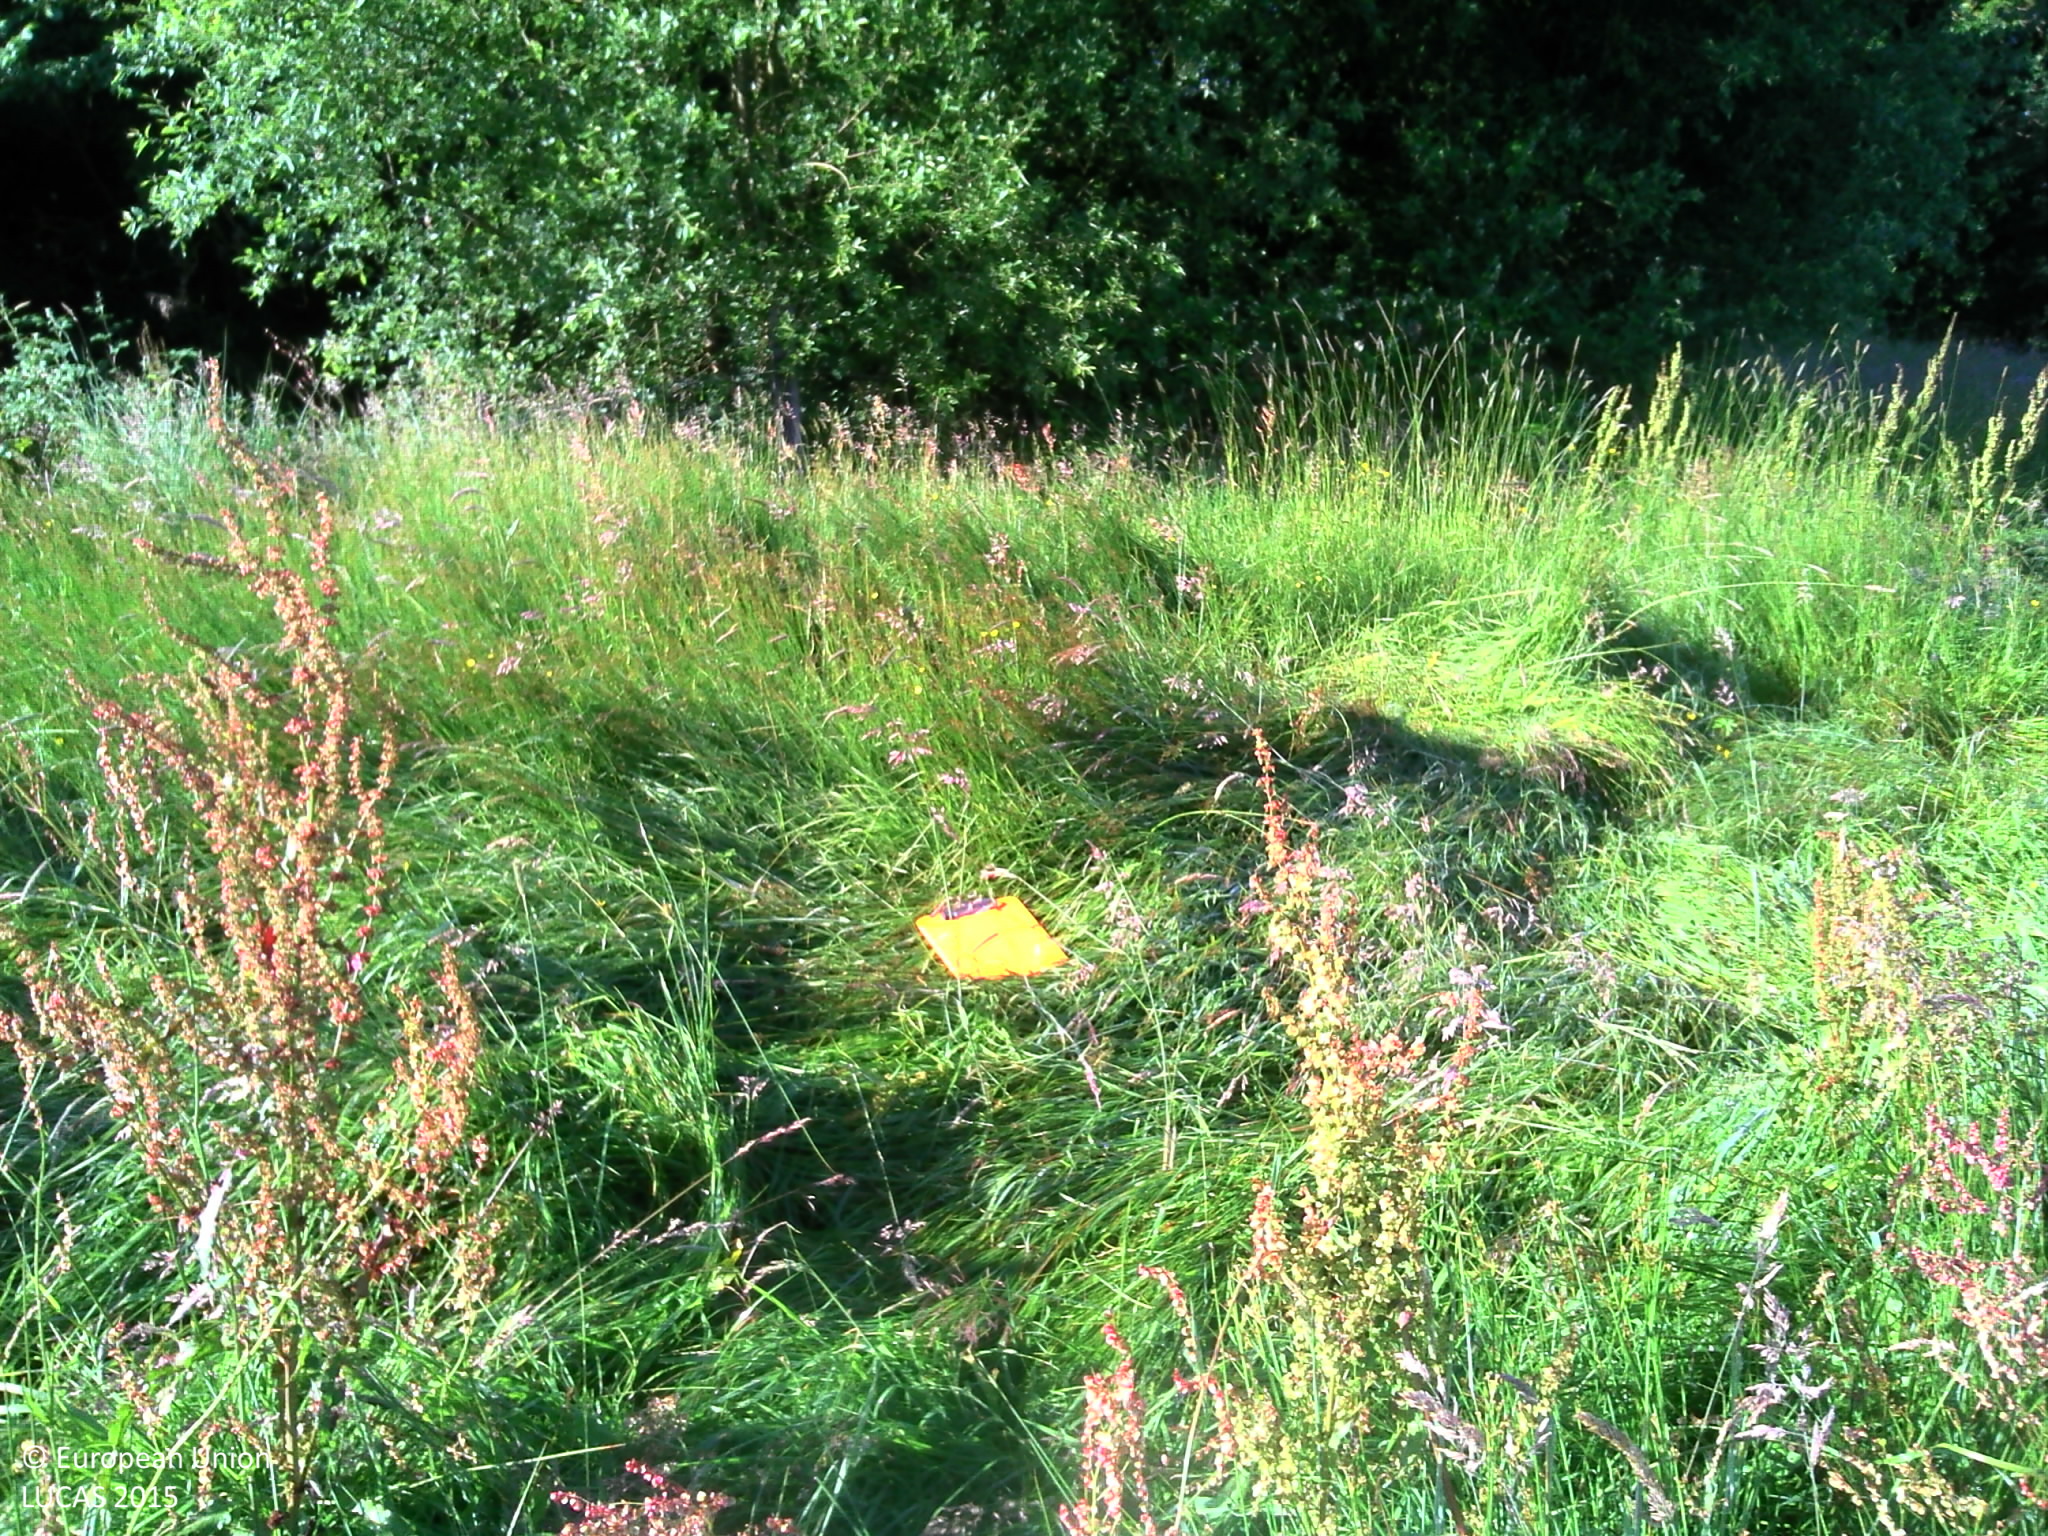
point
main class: Grassland
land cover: Grassland without tree/shrub cover
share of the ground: > 75 %
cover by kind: herbaceous plants 100 %
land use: Agriculture (excluding fallow land and kitchen gardens)
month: June
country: FR
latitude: 49.1056
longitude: 0.3705
